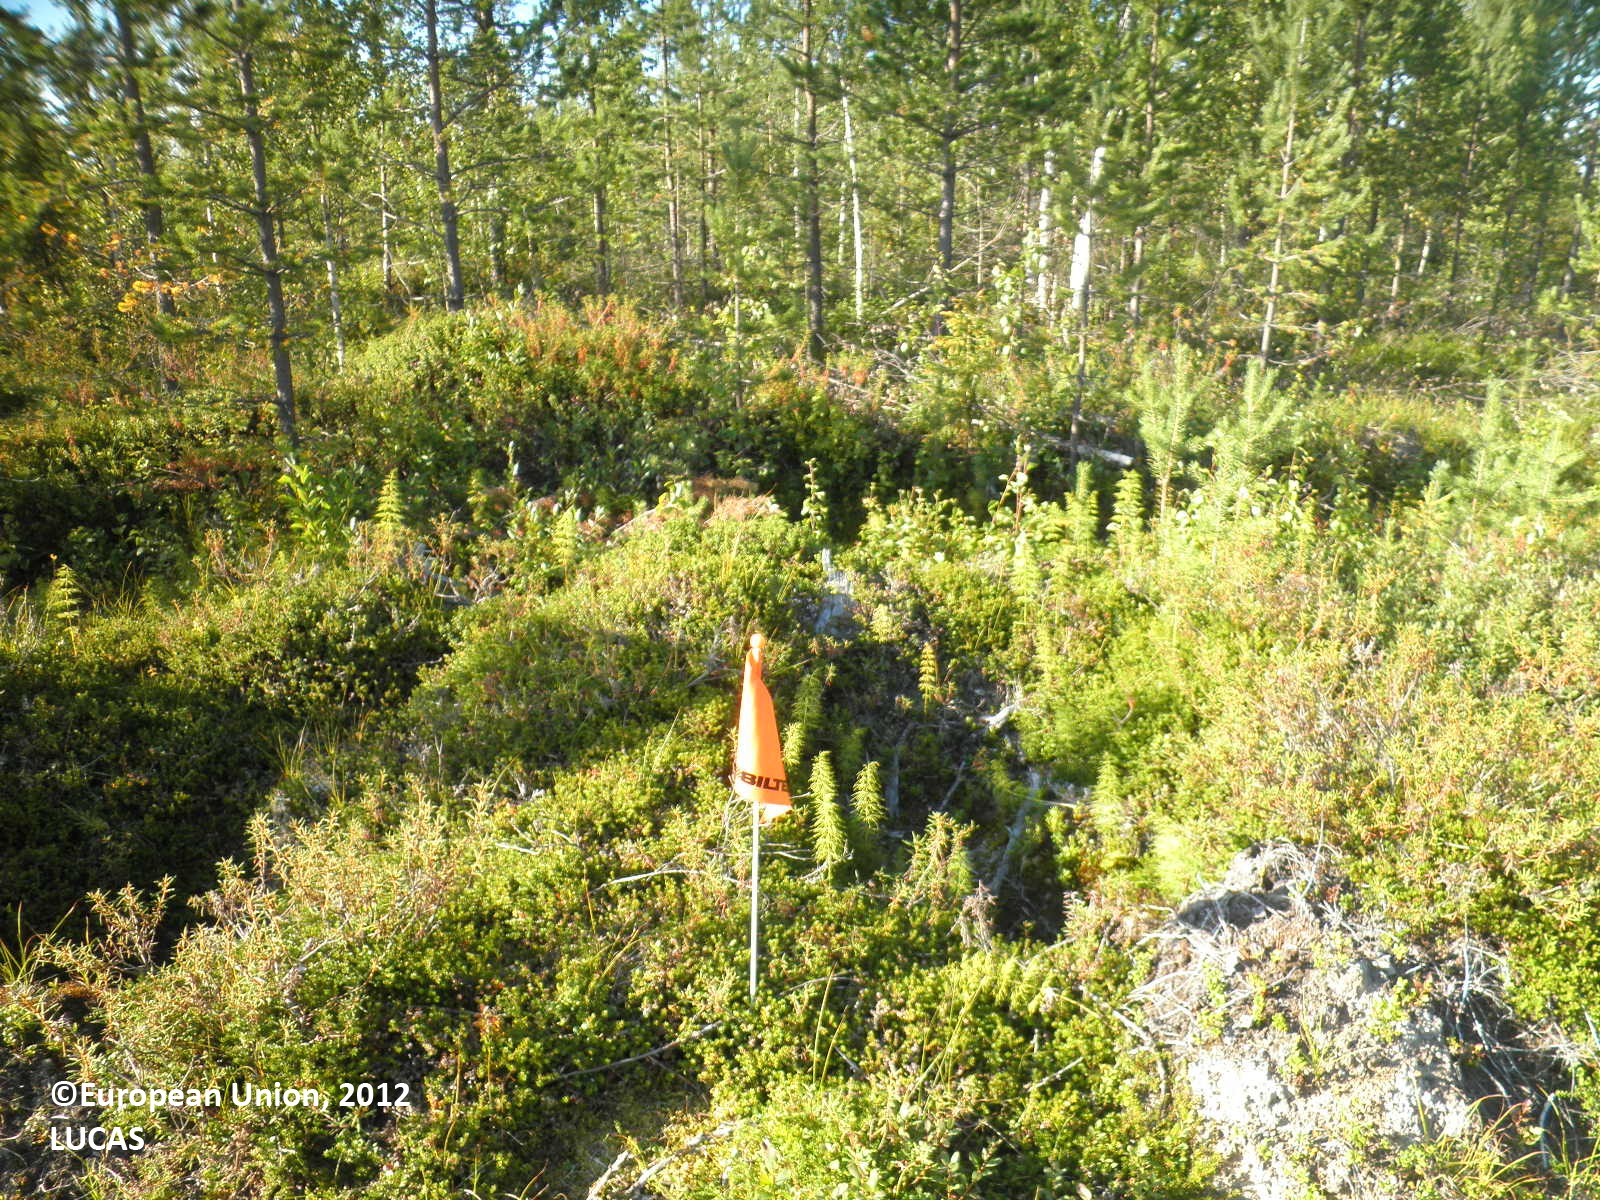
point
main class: Woodland
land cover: Pine dominated mixed woodland
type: boreal forest
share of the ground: 25 - 50 %
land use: Forestry
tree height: < 5 m
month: August
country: FI
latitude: 67.6348
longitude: 27.0630
